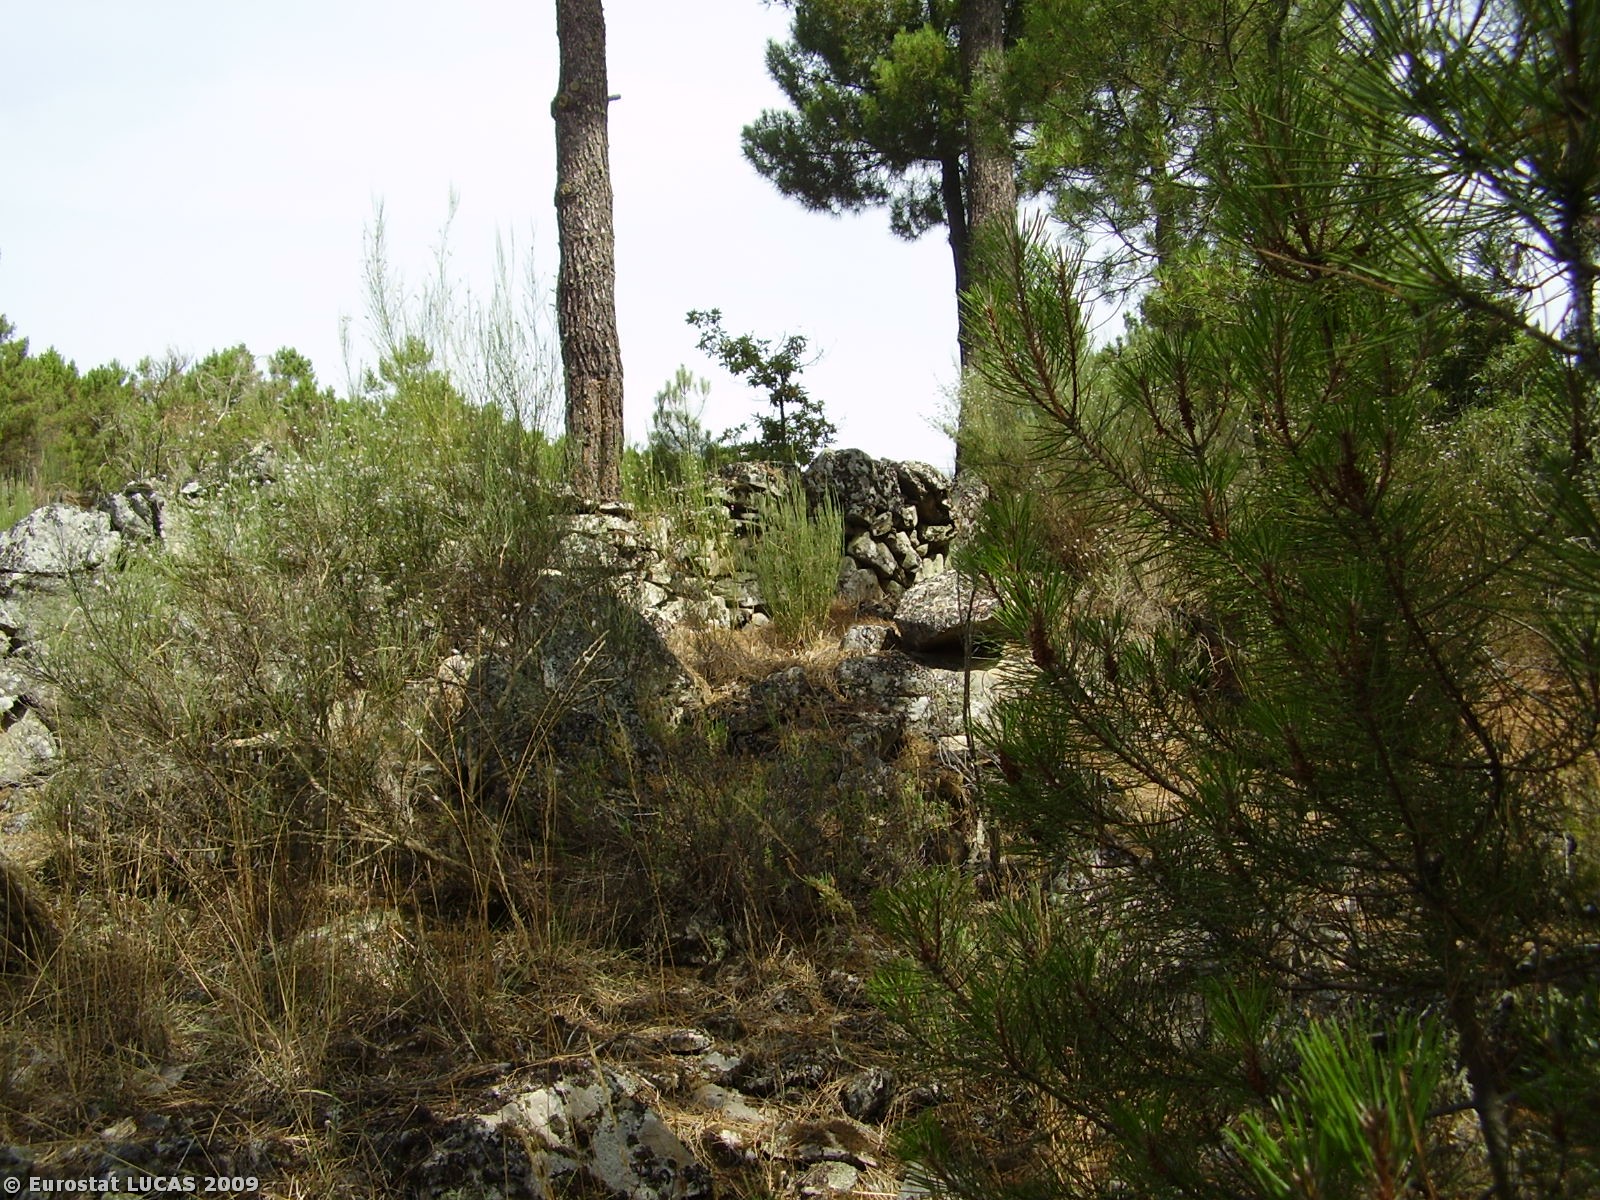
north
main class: Woodland
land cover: Coniferous woodland
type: coniferous forest of the mediterranean region
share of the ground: 10 - 25 %
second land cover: Shrubland with sparse tree cover
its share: < 10 %
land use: Forestry
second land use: Unused
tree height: > 5 m
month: July
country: PT
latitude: 41.3666
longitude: -7.5447
